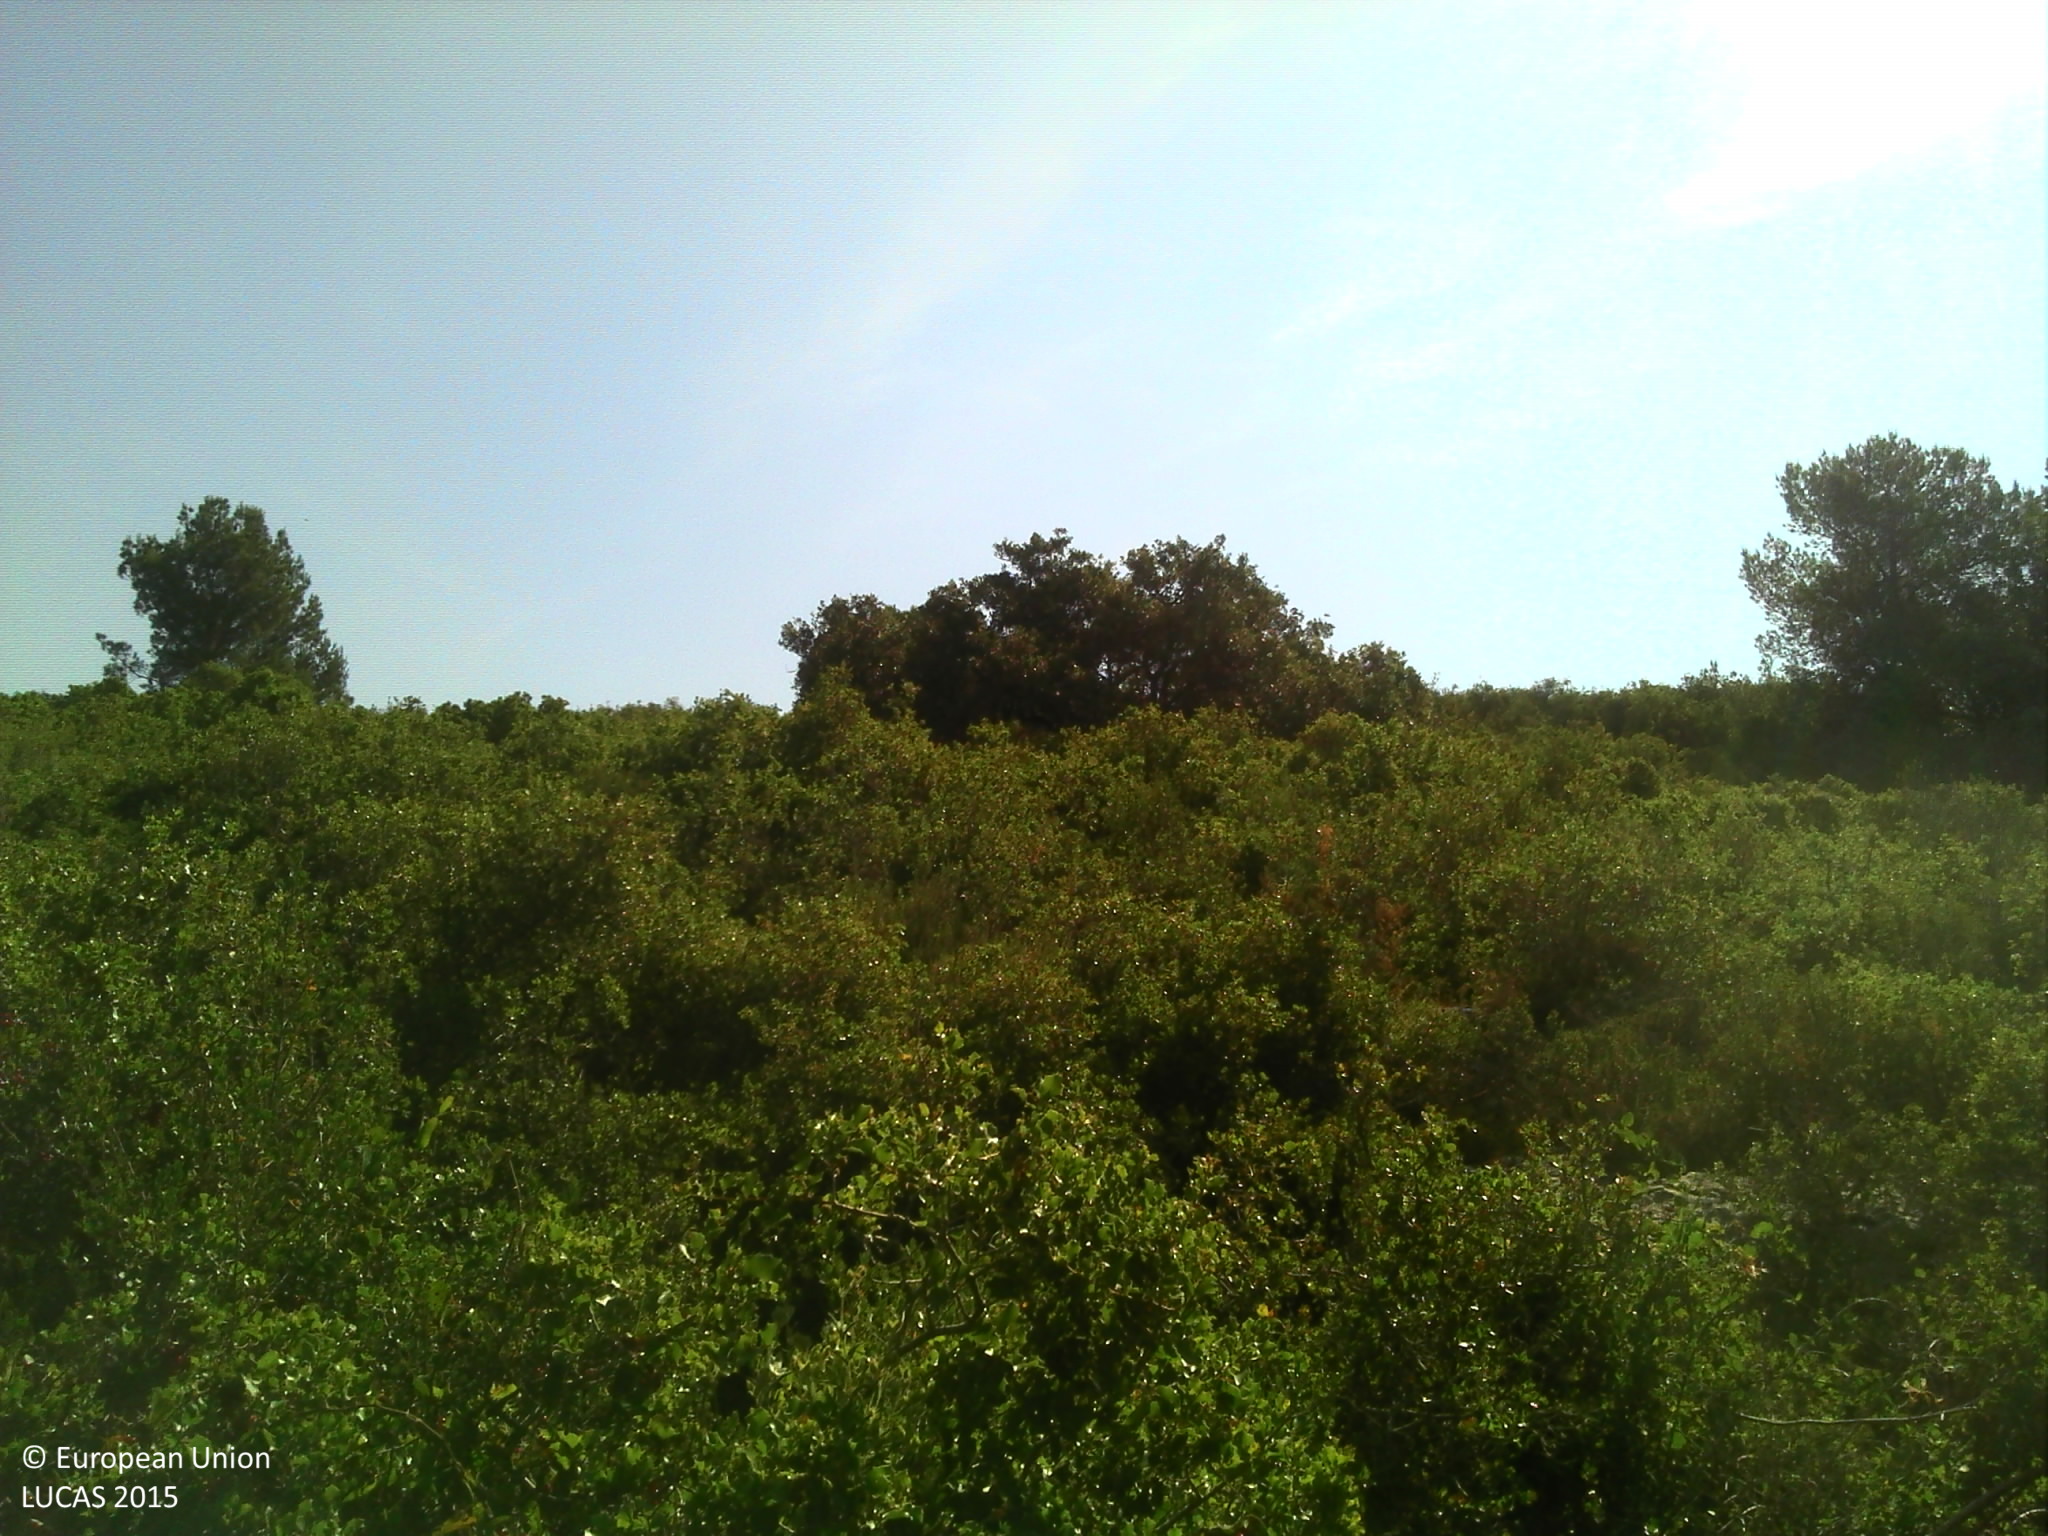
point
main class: Shrubland
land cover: Shrubland with sparse tree cover
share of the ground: > 75 %
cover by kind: shrubs 95 %, coniferous forest trees 5 %
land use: Semi-natural and natural areas not in use
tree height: > 5 m
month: June
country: FR
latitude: 43.1979
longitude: 3.1060
